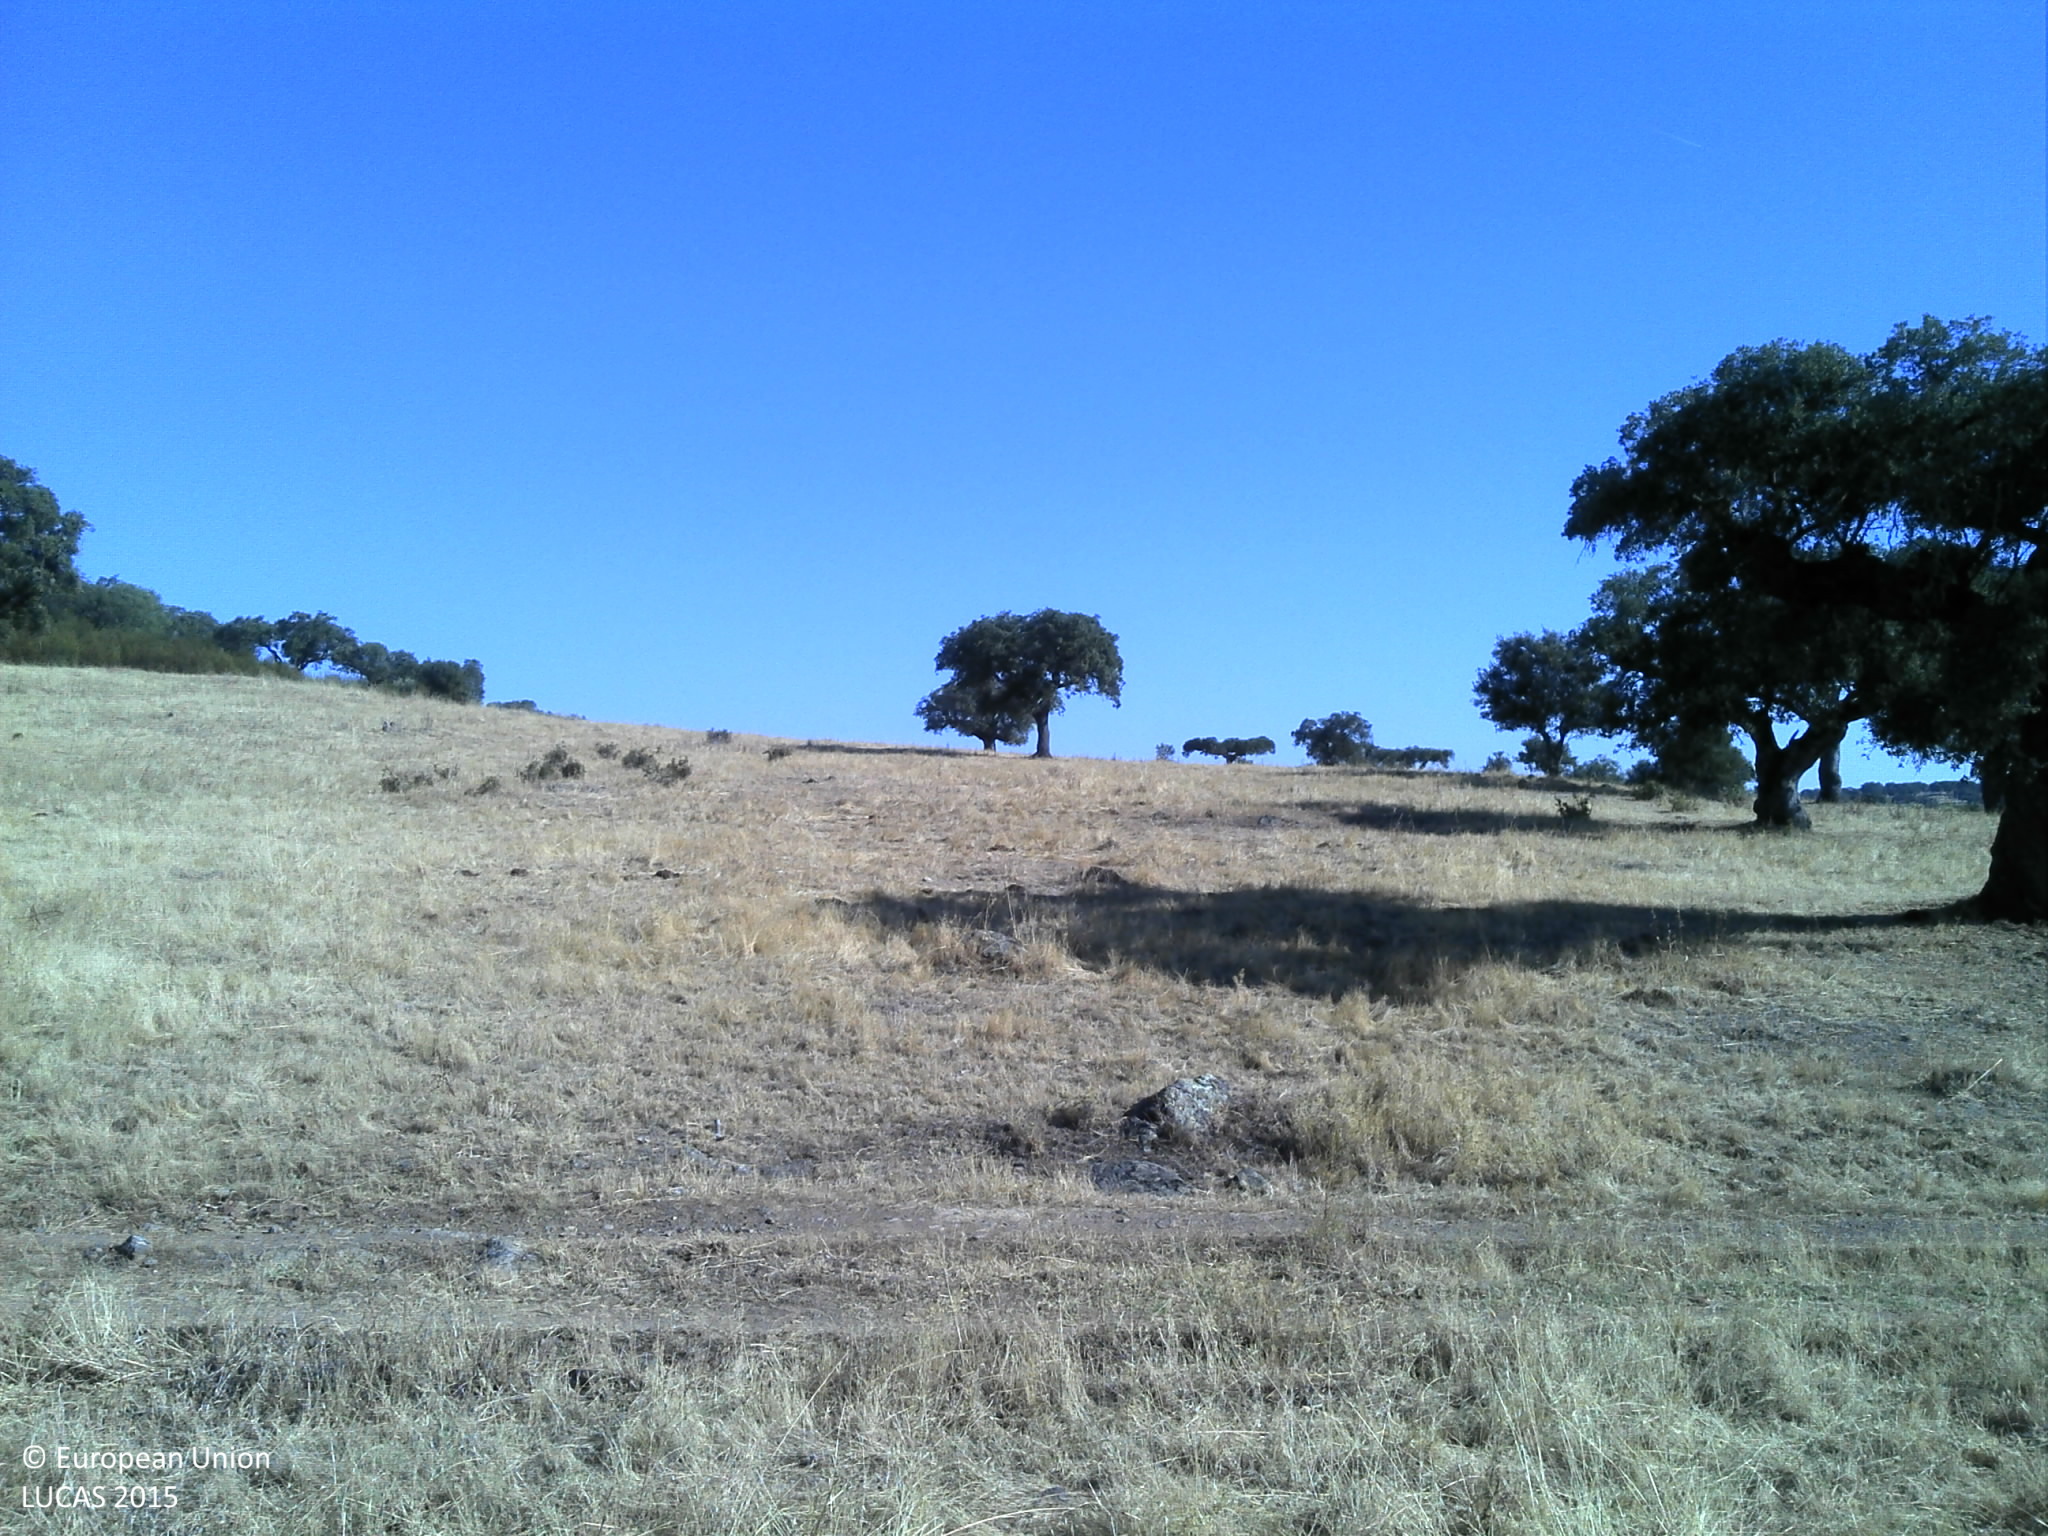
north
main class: Grassland
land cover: Grassland without tree/shrub cover
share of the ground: 50 - 75 %
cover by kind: herbaceous plants 60 %, unconsolidated bare surface 40 %
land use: Agriculture (excluding fallow land and kitchen gardens)
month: July
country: PT
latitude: 38.6619
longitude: -7.2998
